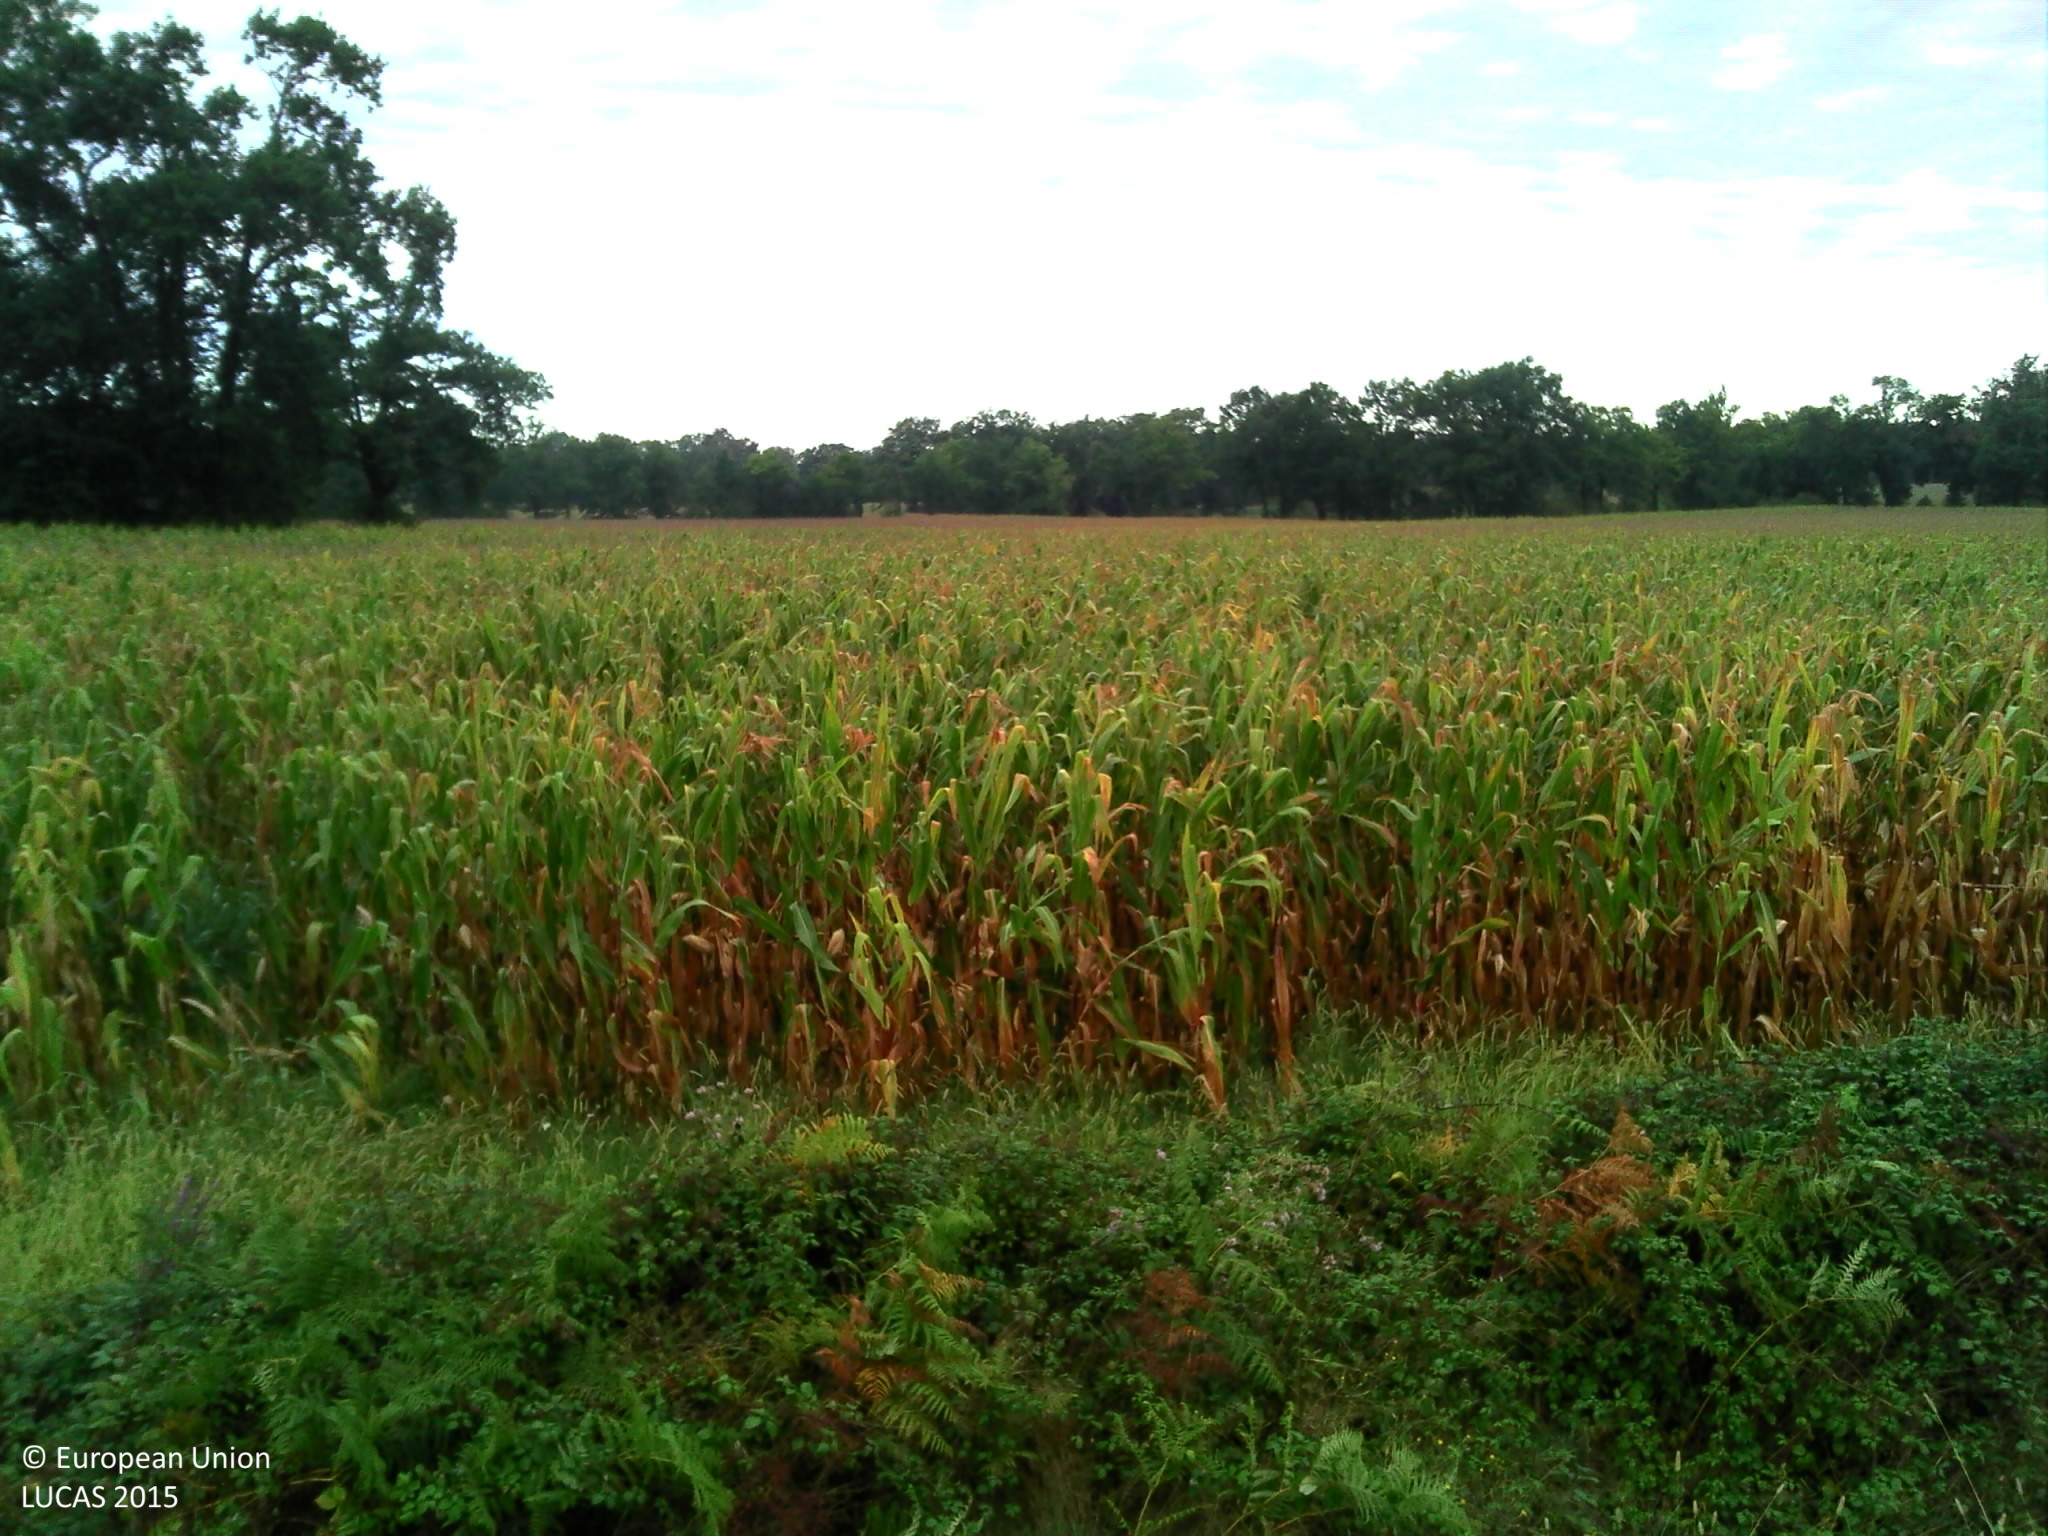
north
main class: Cropland
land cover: Maize
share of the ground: > 75 %
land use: Agriculture (excluding fallow land and kitchen gardens)
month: September
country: FR
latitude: 43.4502
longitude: -0.5252
